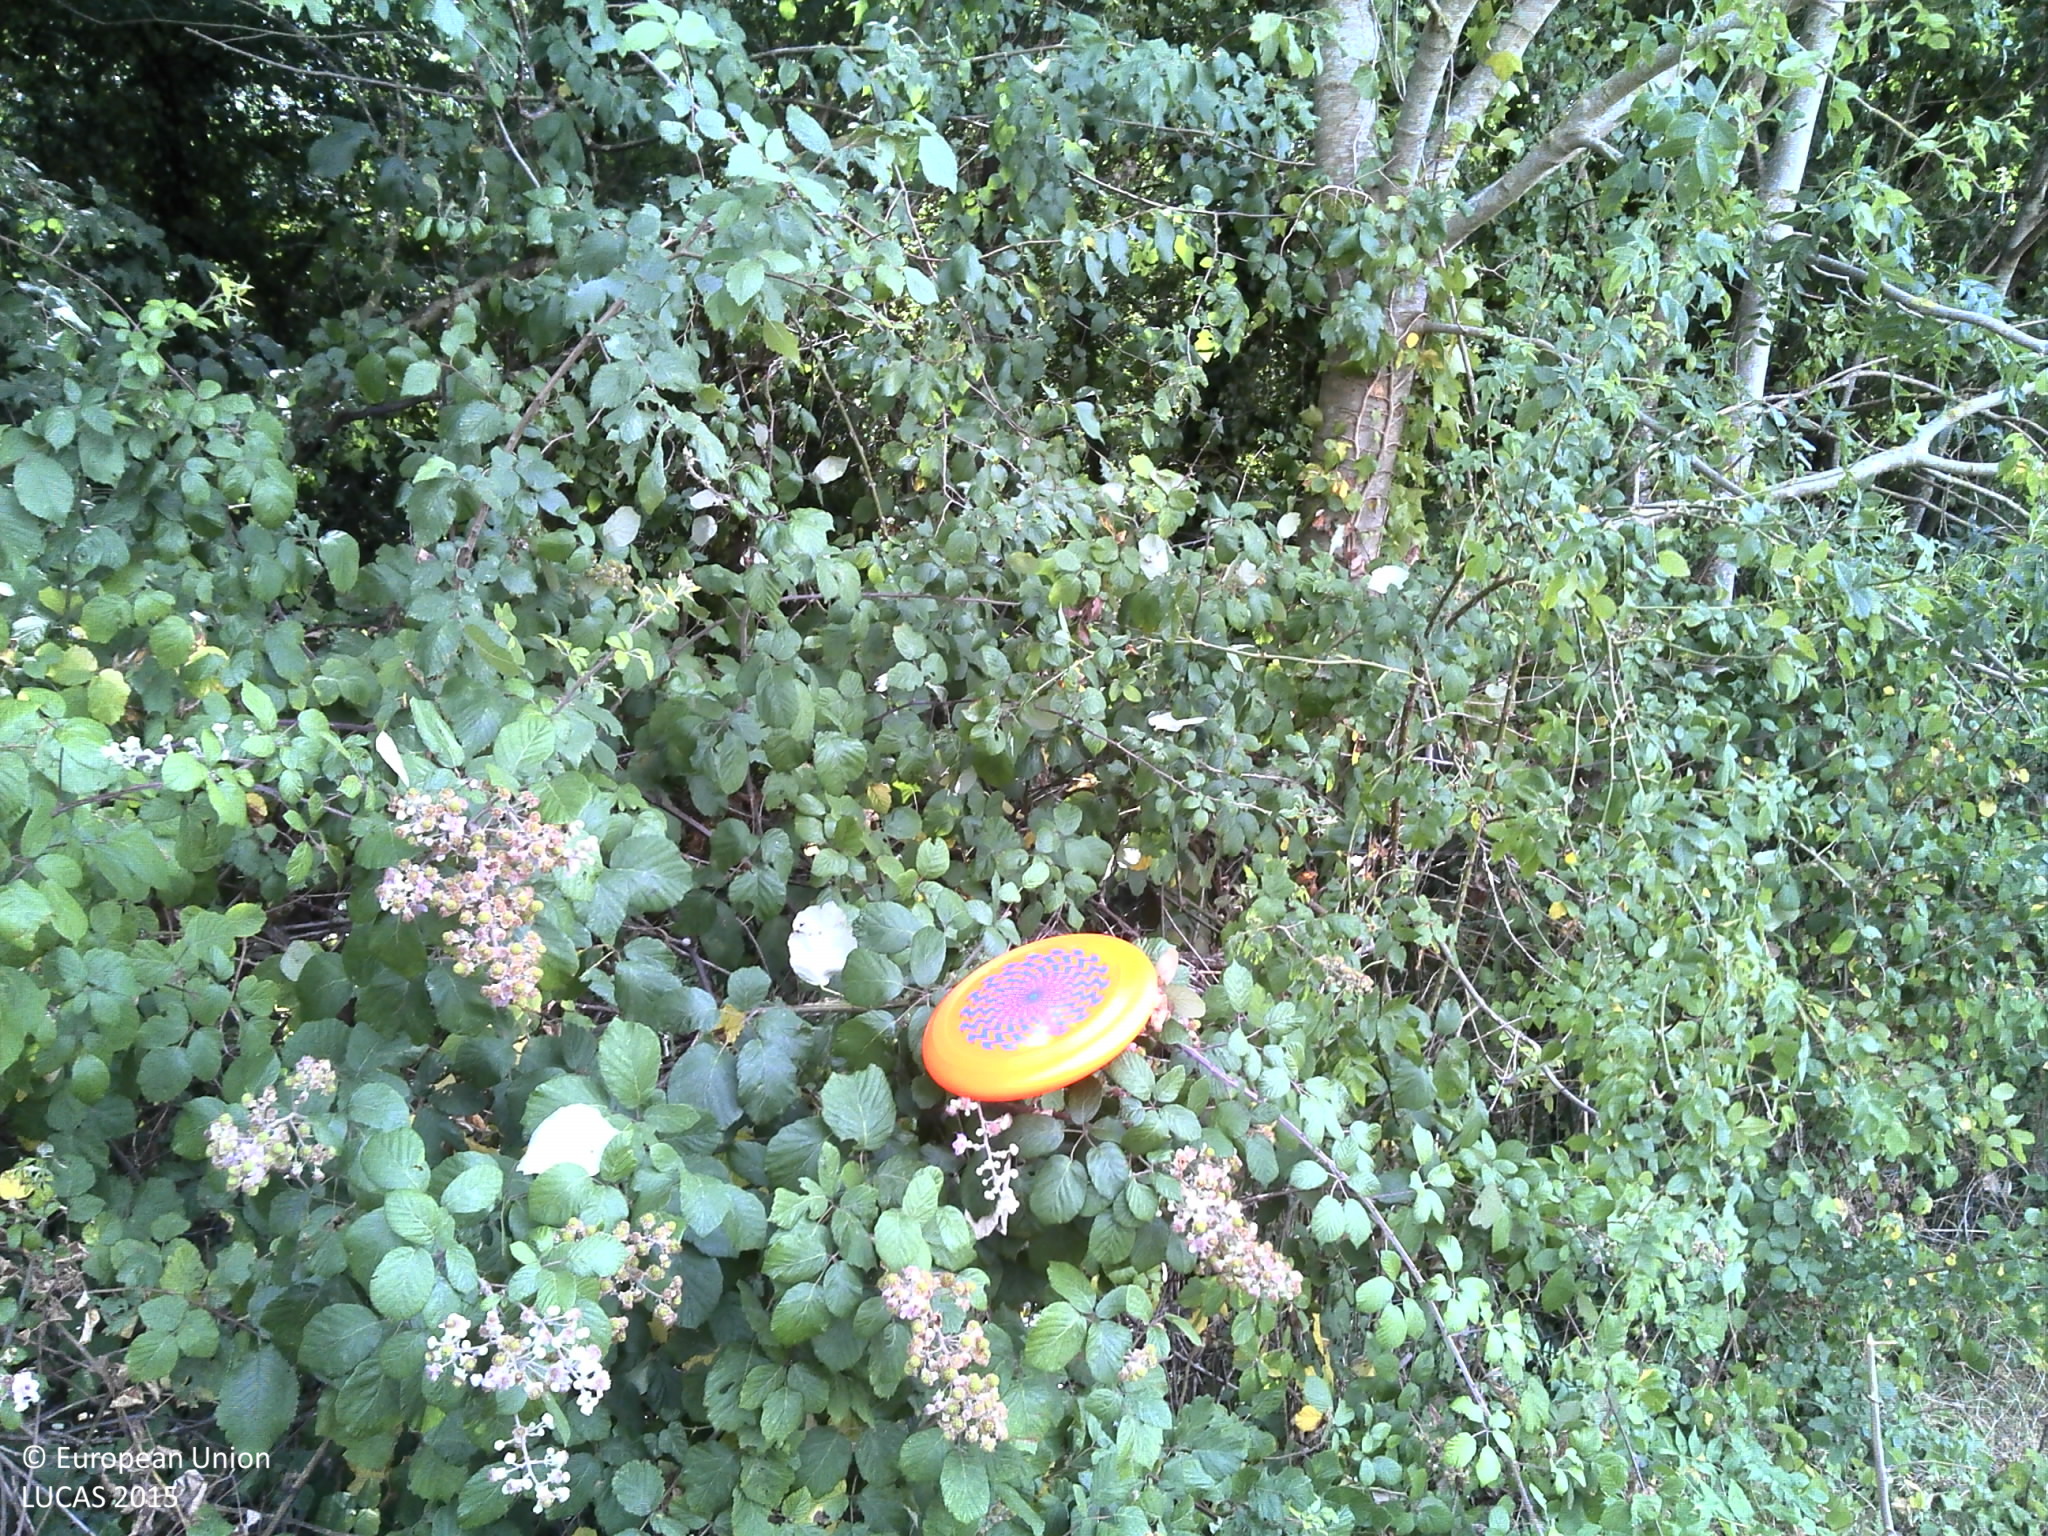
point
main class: Woodland
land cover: Broadleaved woodland
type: beech forest
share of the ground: > 75 %
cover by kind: broadleaved forest trees 100 %
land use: Forestry
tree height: > 5 m
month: July
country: FR
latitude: 48.5763
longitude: 2.4120
